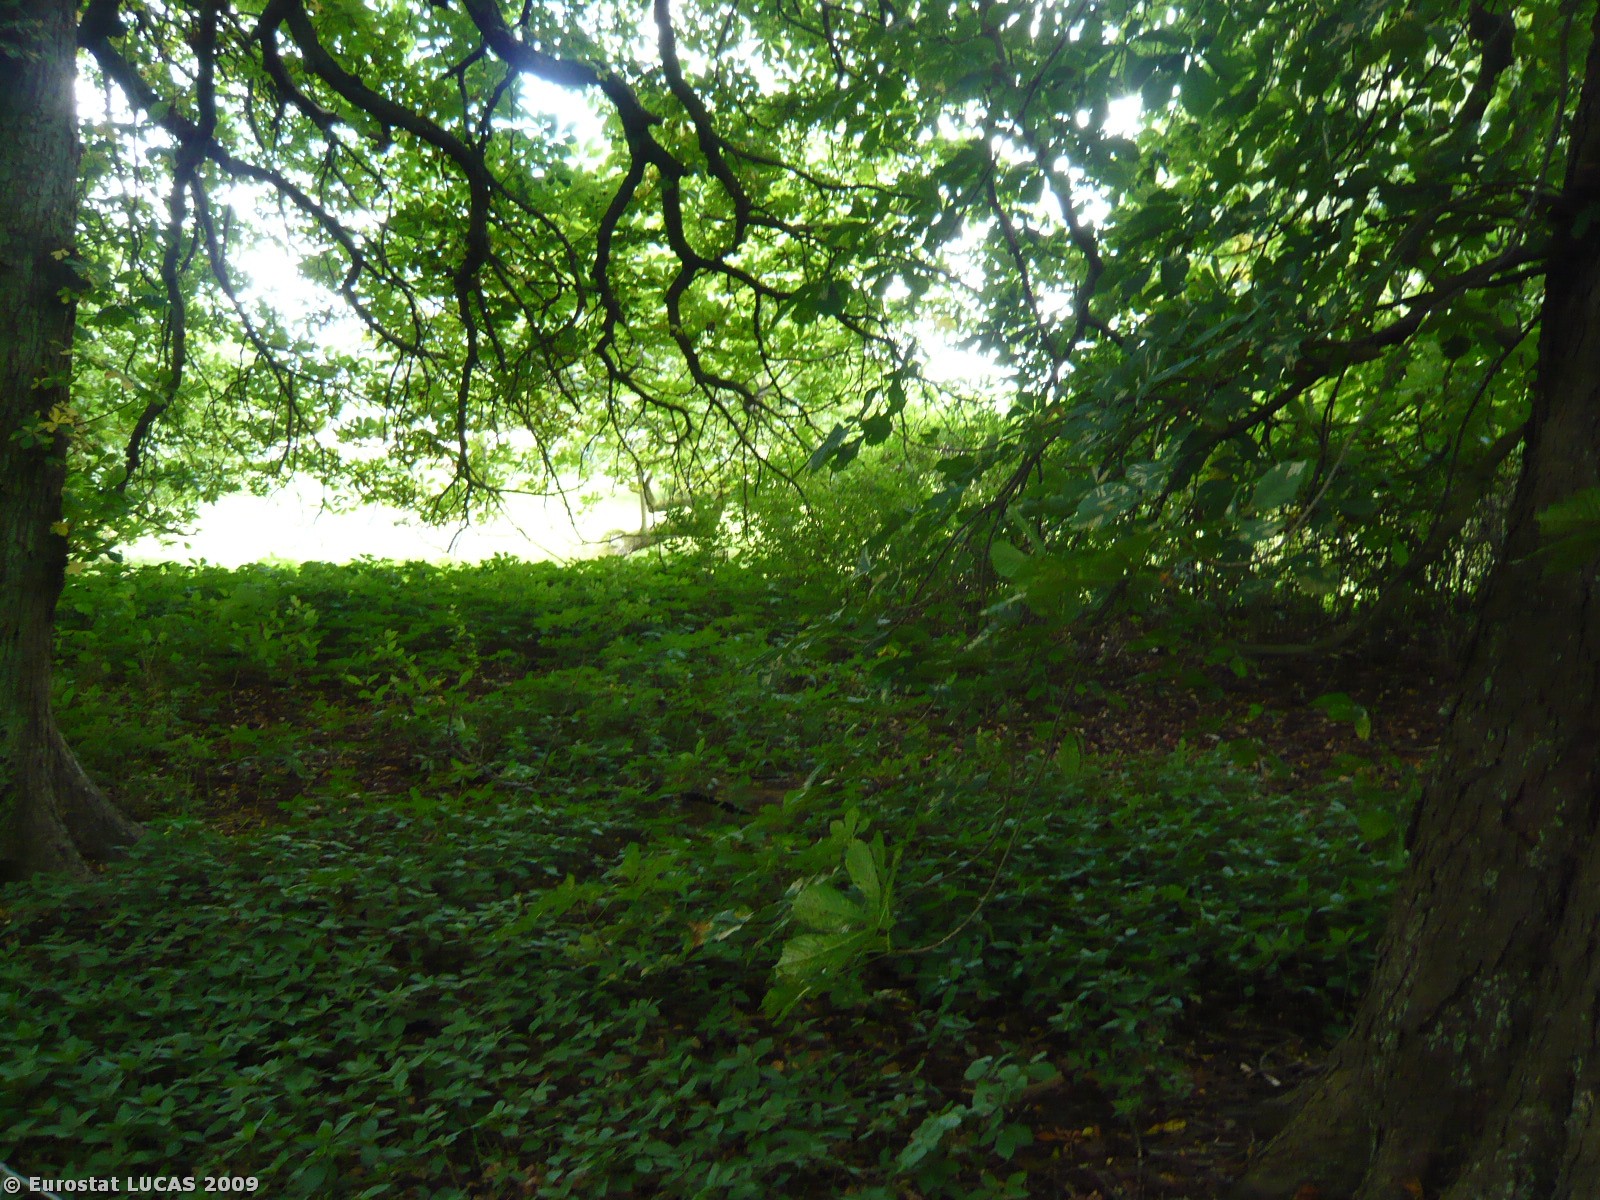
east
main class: Woodland
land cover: Broadleaved woodland
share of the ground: > 75 %
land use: Residential
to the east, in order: Broadleaved woodland; Artificial constructions in urban areas; Temporary grasslands
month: July
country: DK
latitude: 55.4359
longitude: 11.9424
